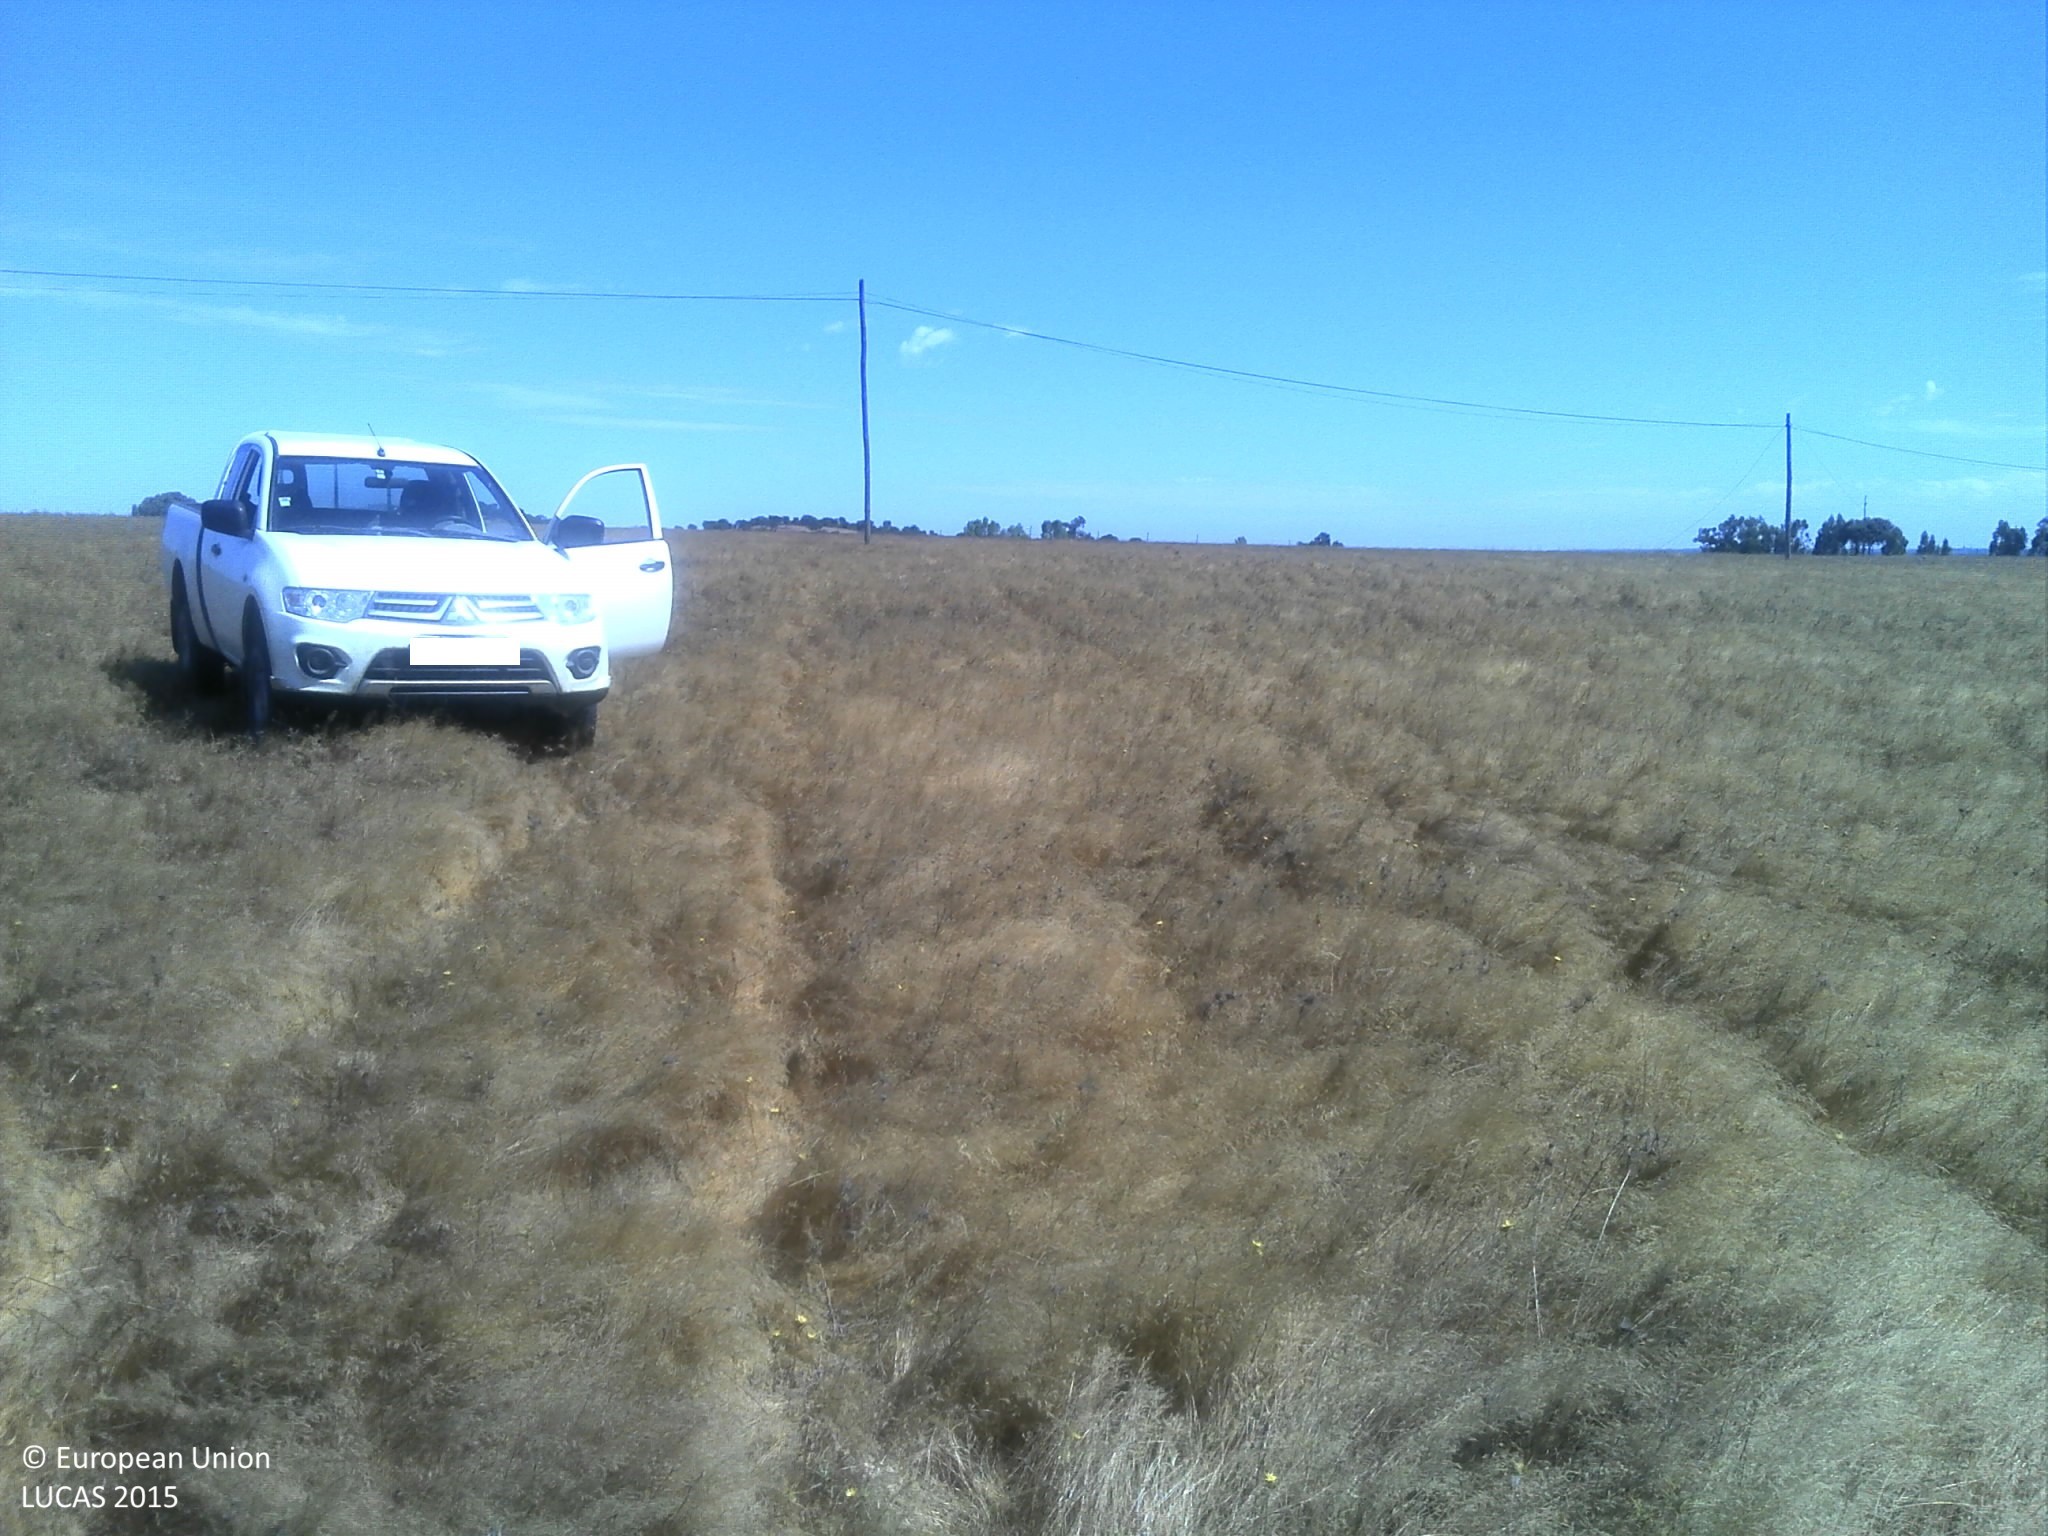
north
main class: Grassland
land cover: Grassland without tree/shrub cover
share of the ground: > 75 %
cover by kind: herbaceous plants 75 %, consolidated bare surface 25 %
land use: Agriculture (excluding fallow land and kitchen gardens)
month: August
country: PT
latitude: 37.7493
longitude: -8.5033
